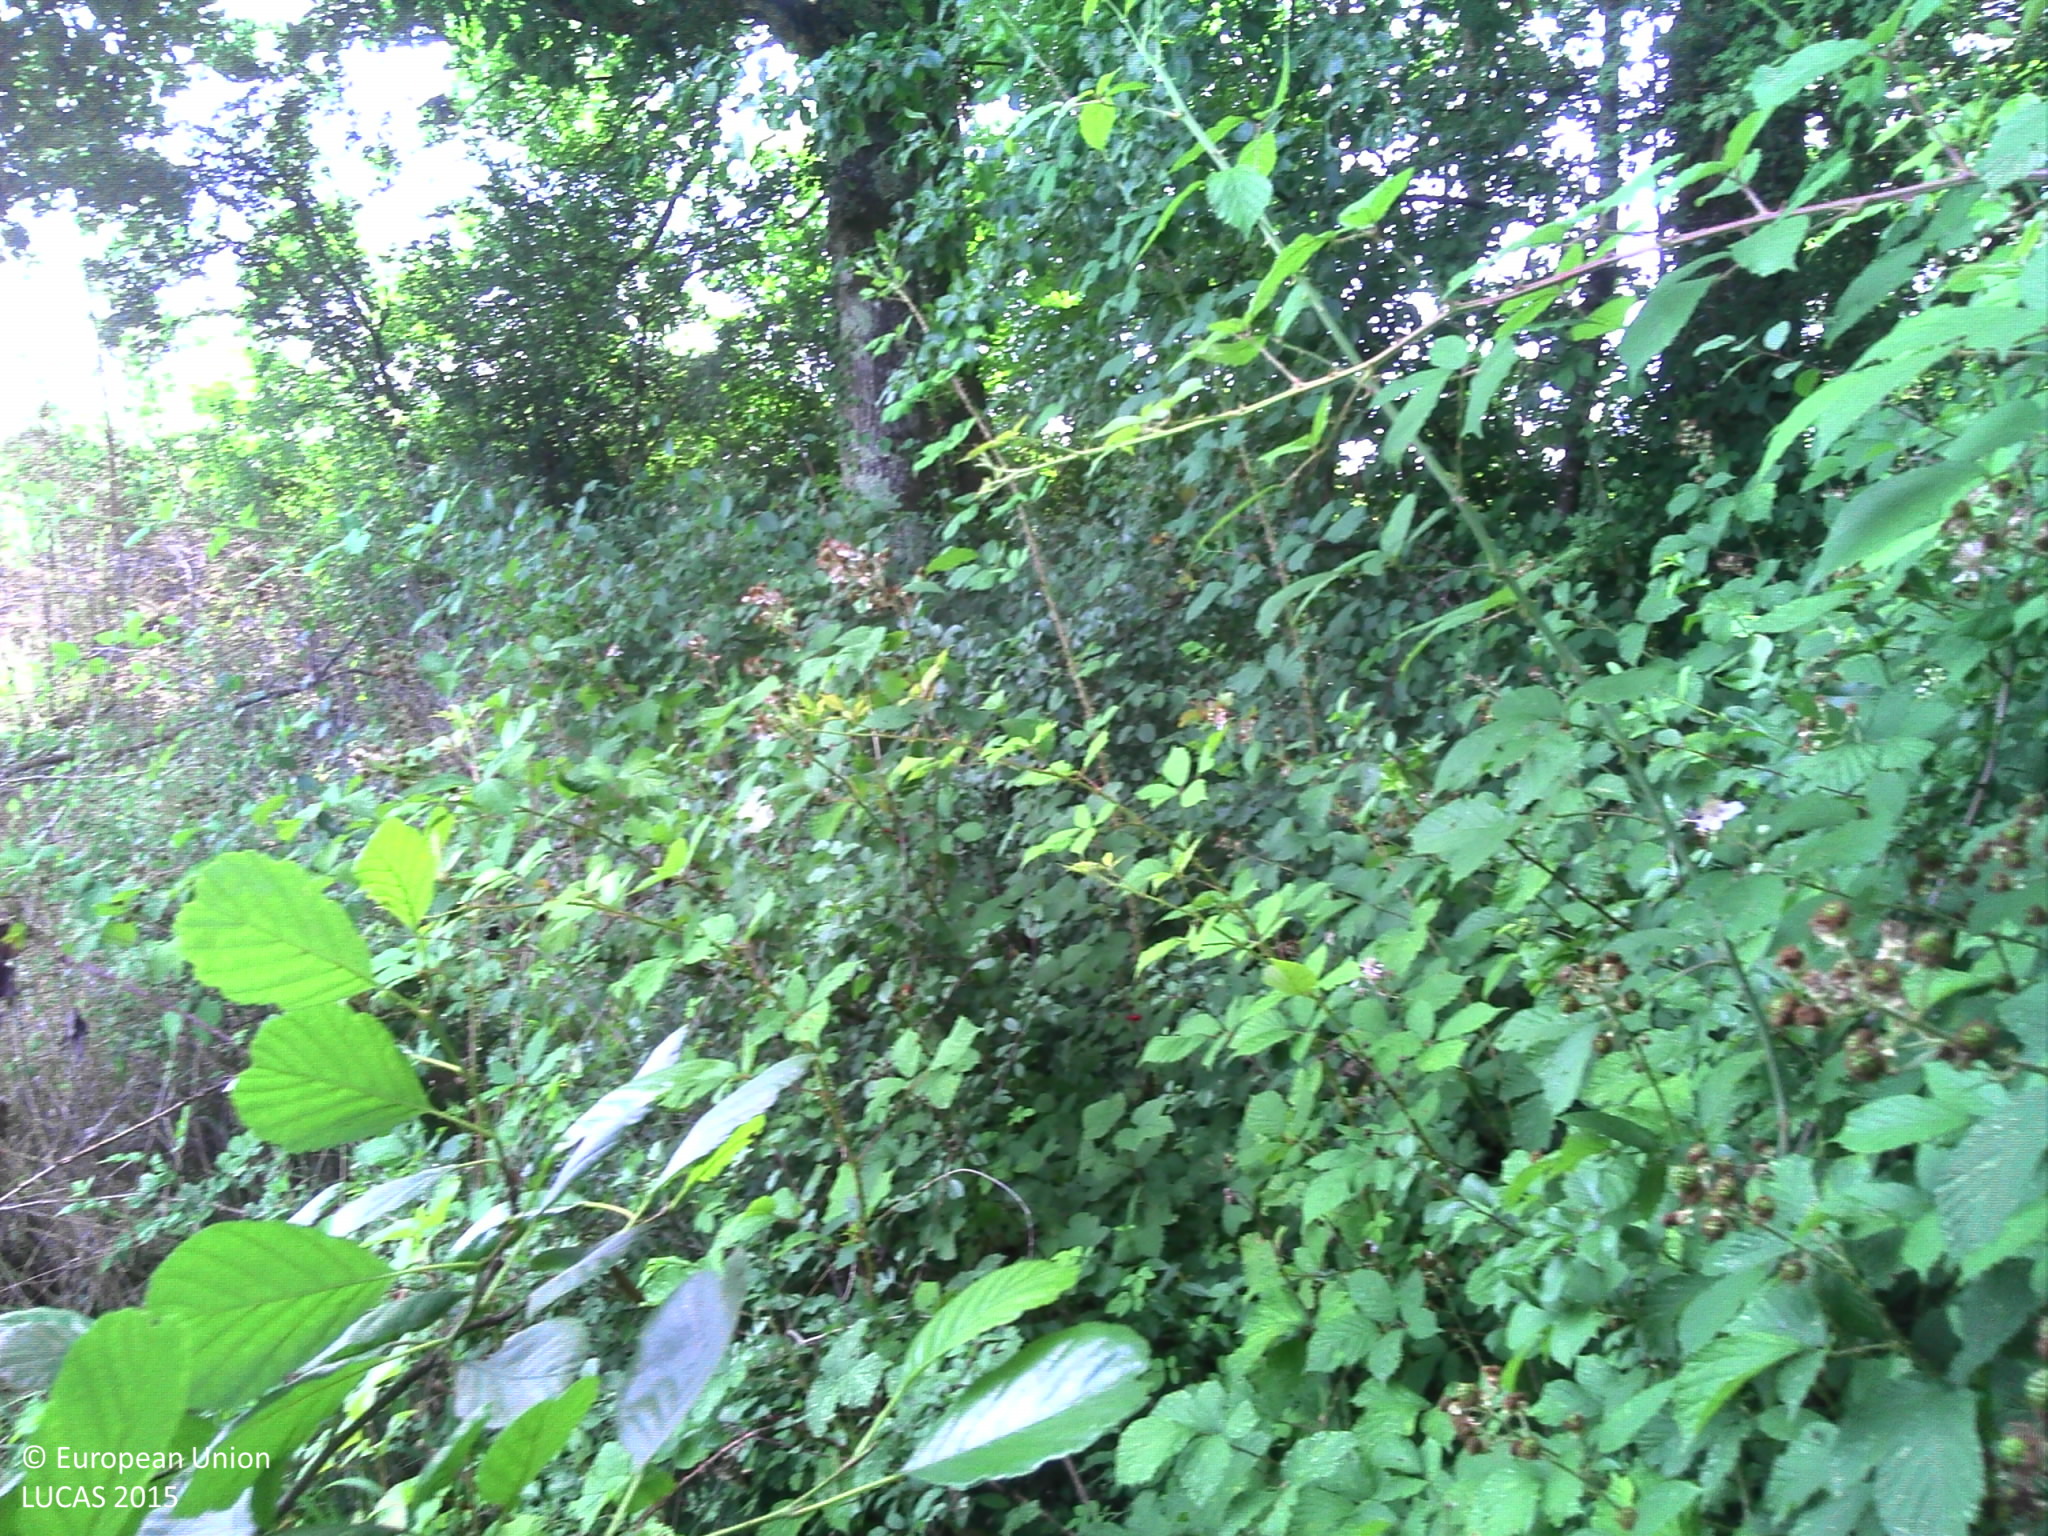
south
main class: Woodland
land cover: Broadleaved woodland
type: acidophilous oak and oak-birch forest
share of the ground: > 75 %
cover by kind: broadleaved forest trees 70 %, shrubs 20 %, herbaceous plants 10 %
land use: Forestry
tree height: > 5 m
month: June
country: FR
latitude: 46.4477
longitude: 5.3292
